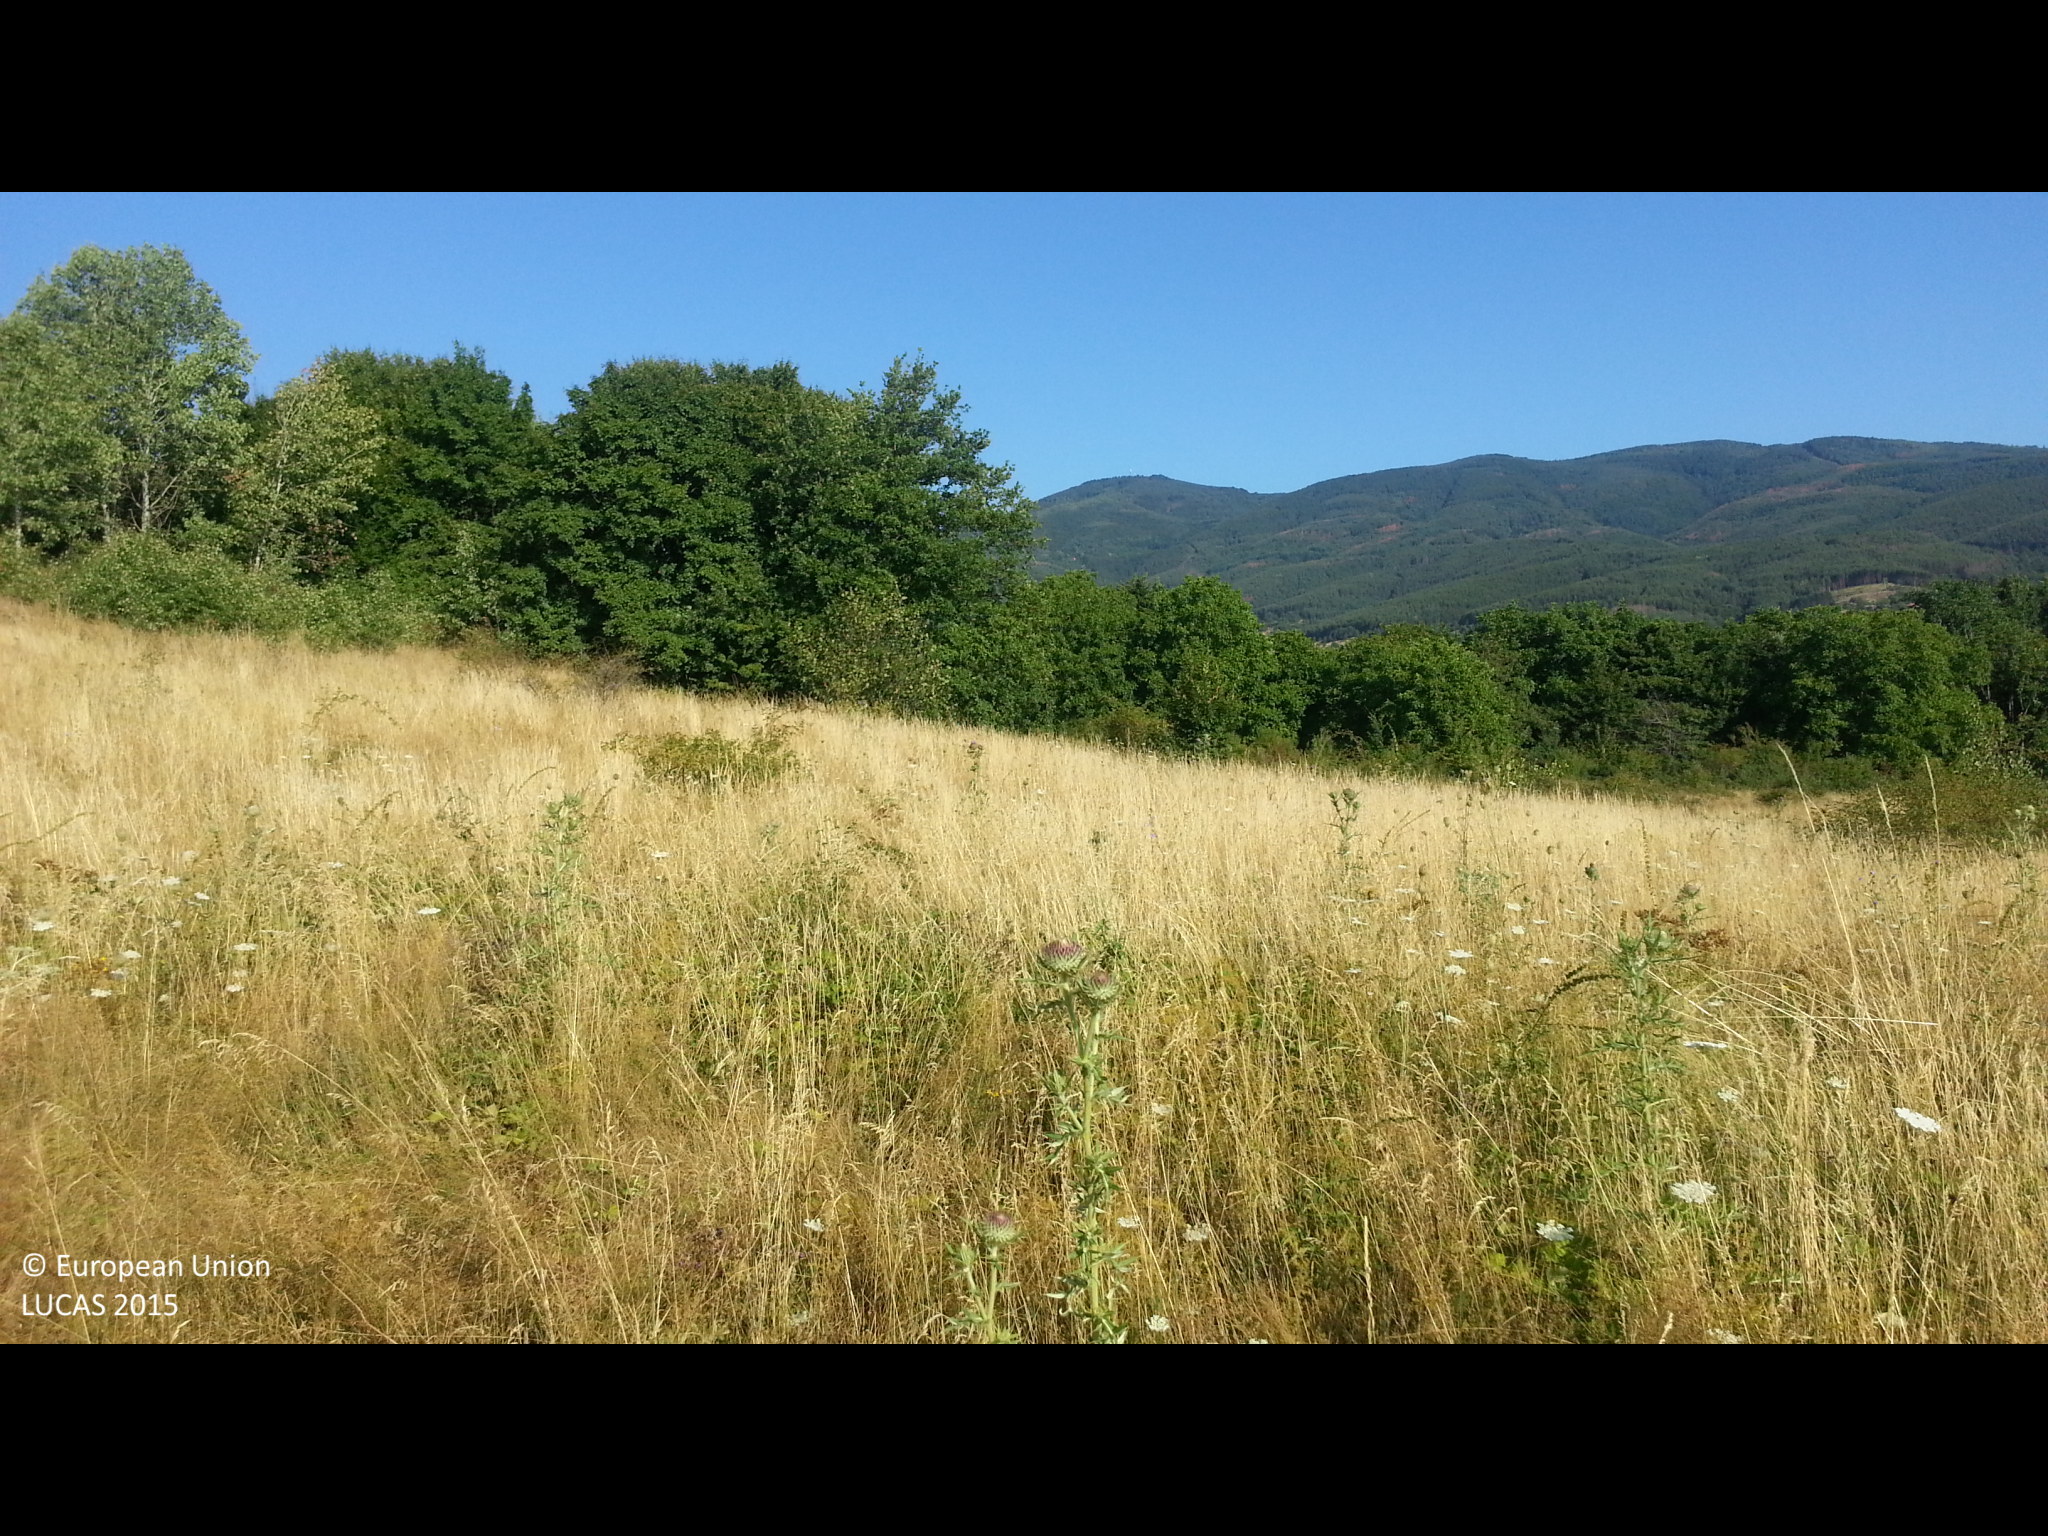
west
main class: Grassland
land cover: Grassland without tree/shrub cover
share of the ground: > 75 %
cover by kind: herbaceous plants 95 %, shrubs 5 %
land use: Semi-natural and natural areas not in use
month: August
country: BG
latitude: 42.2633
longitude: 22.6163
